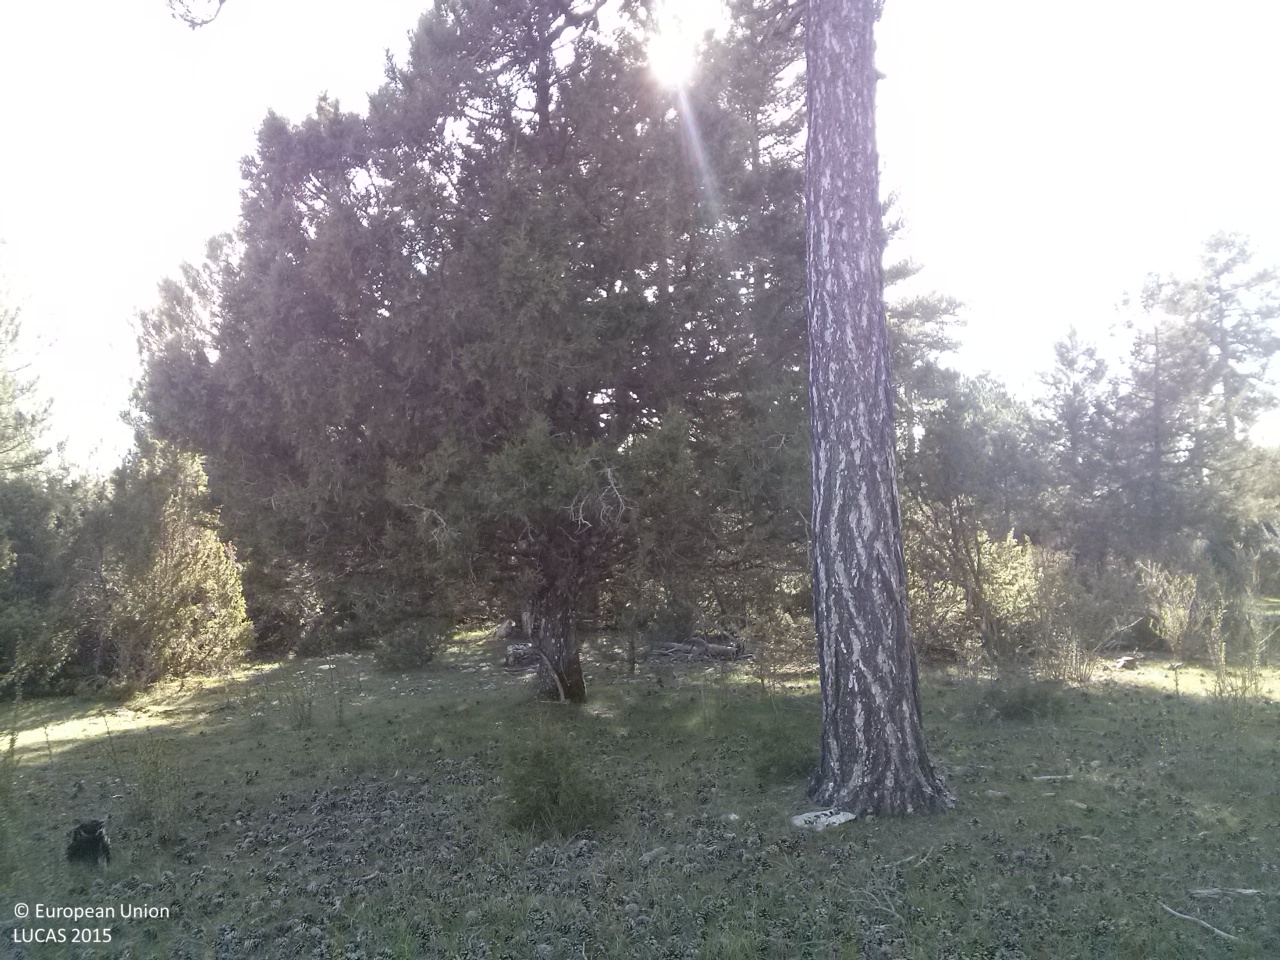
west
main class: Woodland
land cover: Other coniferous woodland
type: coniferous forest of the mediterranean region
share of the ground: 25 - 50 %
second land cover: Grassland without tree/shrub cover
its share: 50 - 75 %
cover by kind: herbaceous plants 60 %, coniferous forest trees 35 %, shrubs 5 %
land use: Forestry
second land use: Agriculture (excluding fallow land and kitchen gardens)
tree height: > 5 m
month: April
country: ES
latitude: 40.1482
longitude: -1.8586
